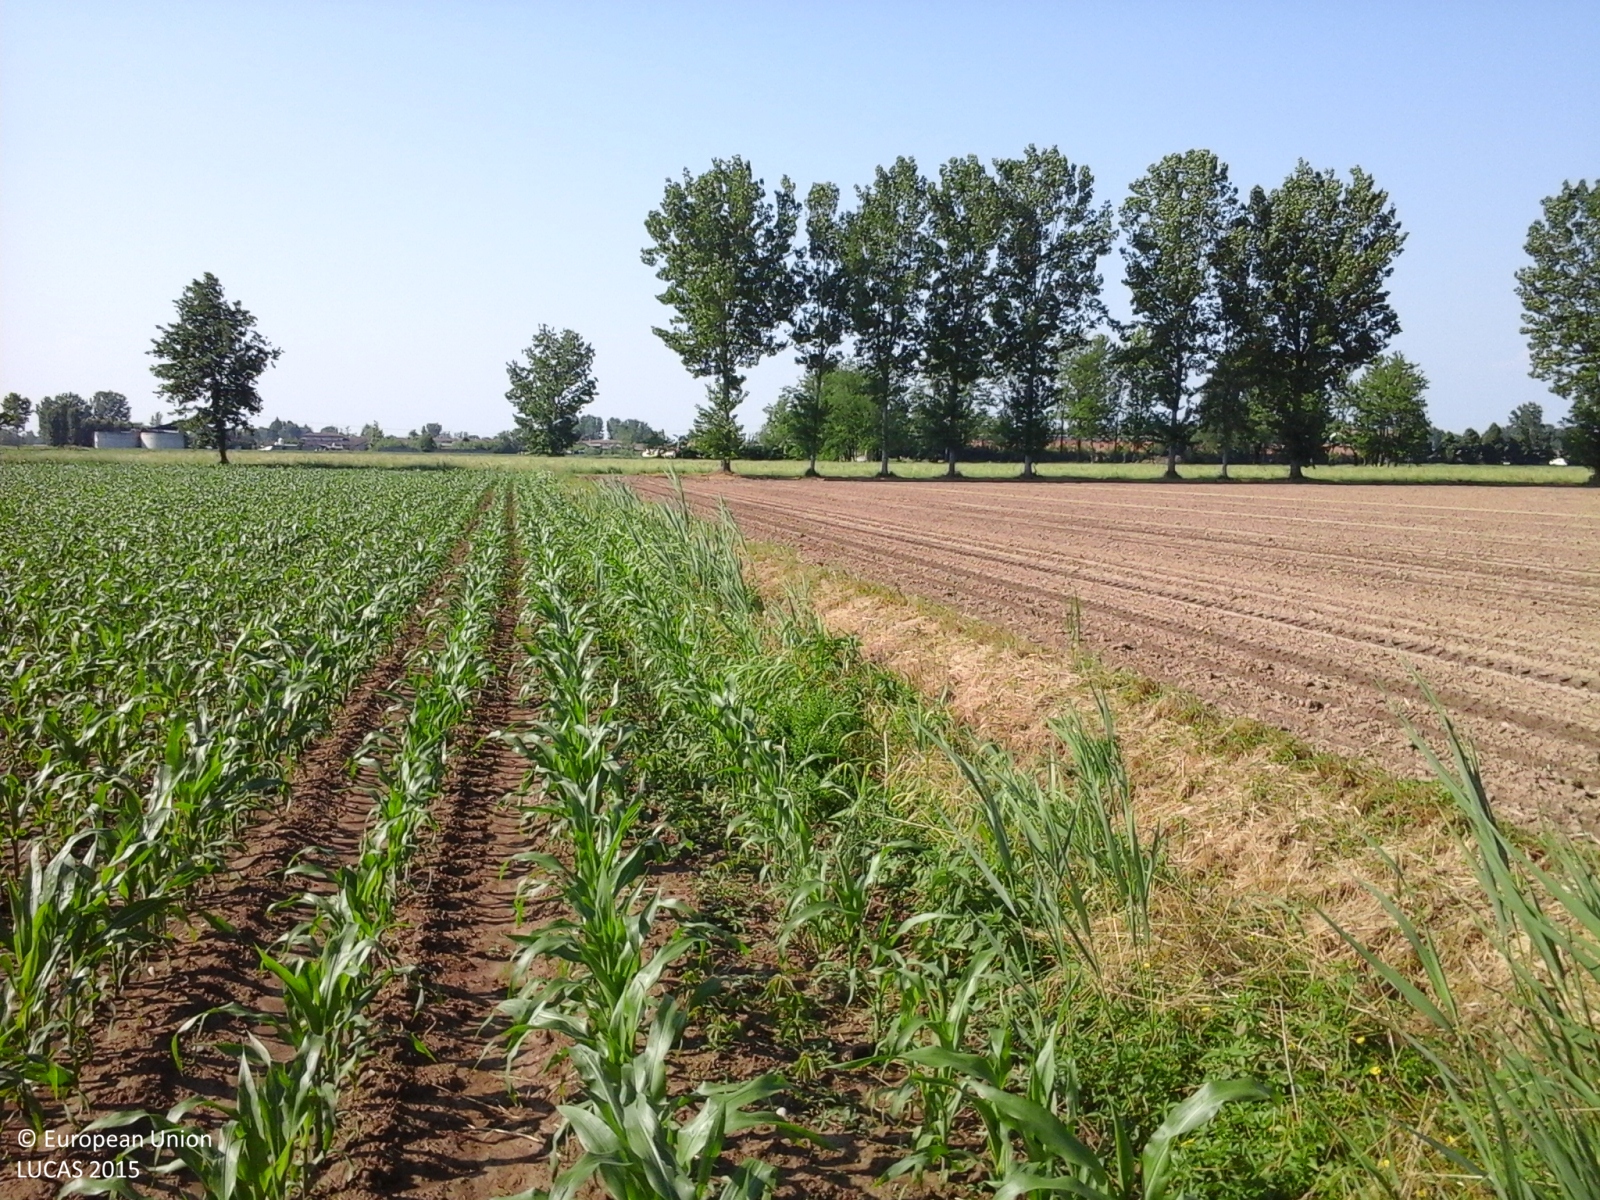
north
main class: Cropland
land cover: Maize
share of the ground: 25 - 50 %
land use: Agriculture (excluding fallow land and kitchen gardens)
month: May
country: IT
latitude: 45.3415
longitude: 9.6306
